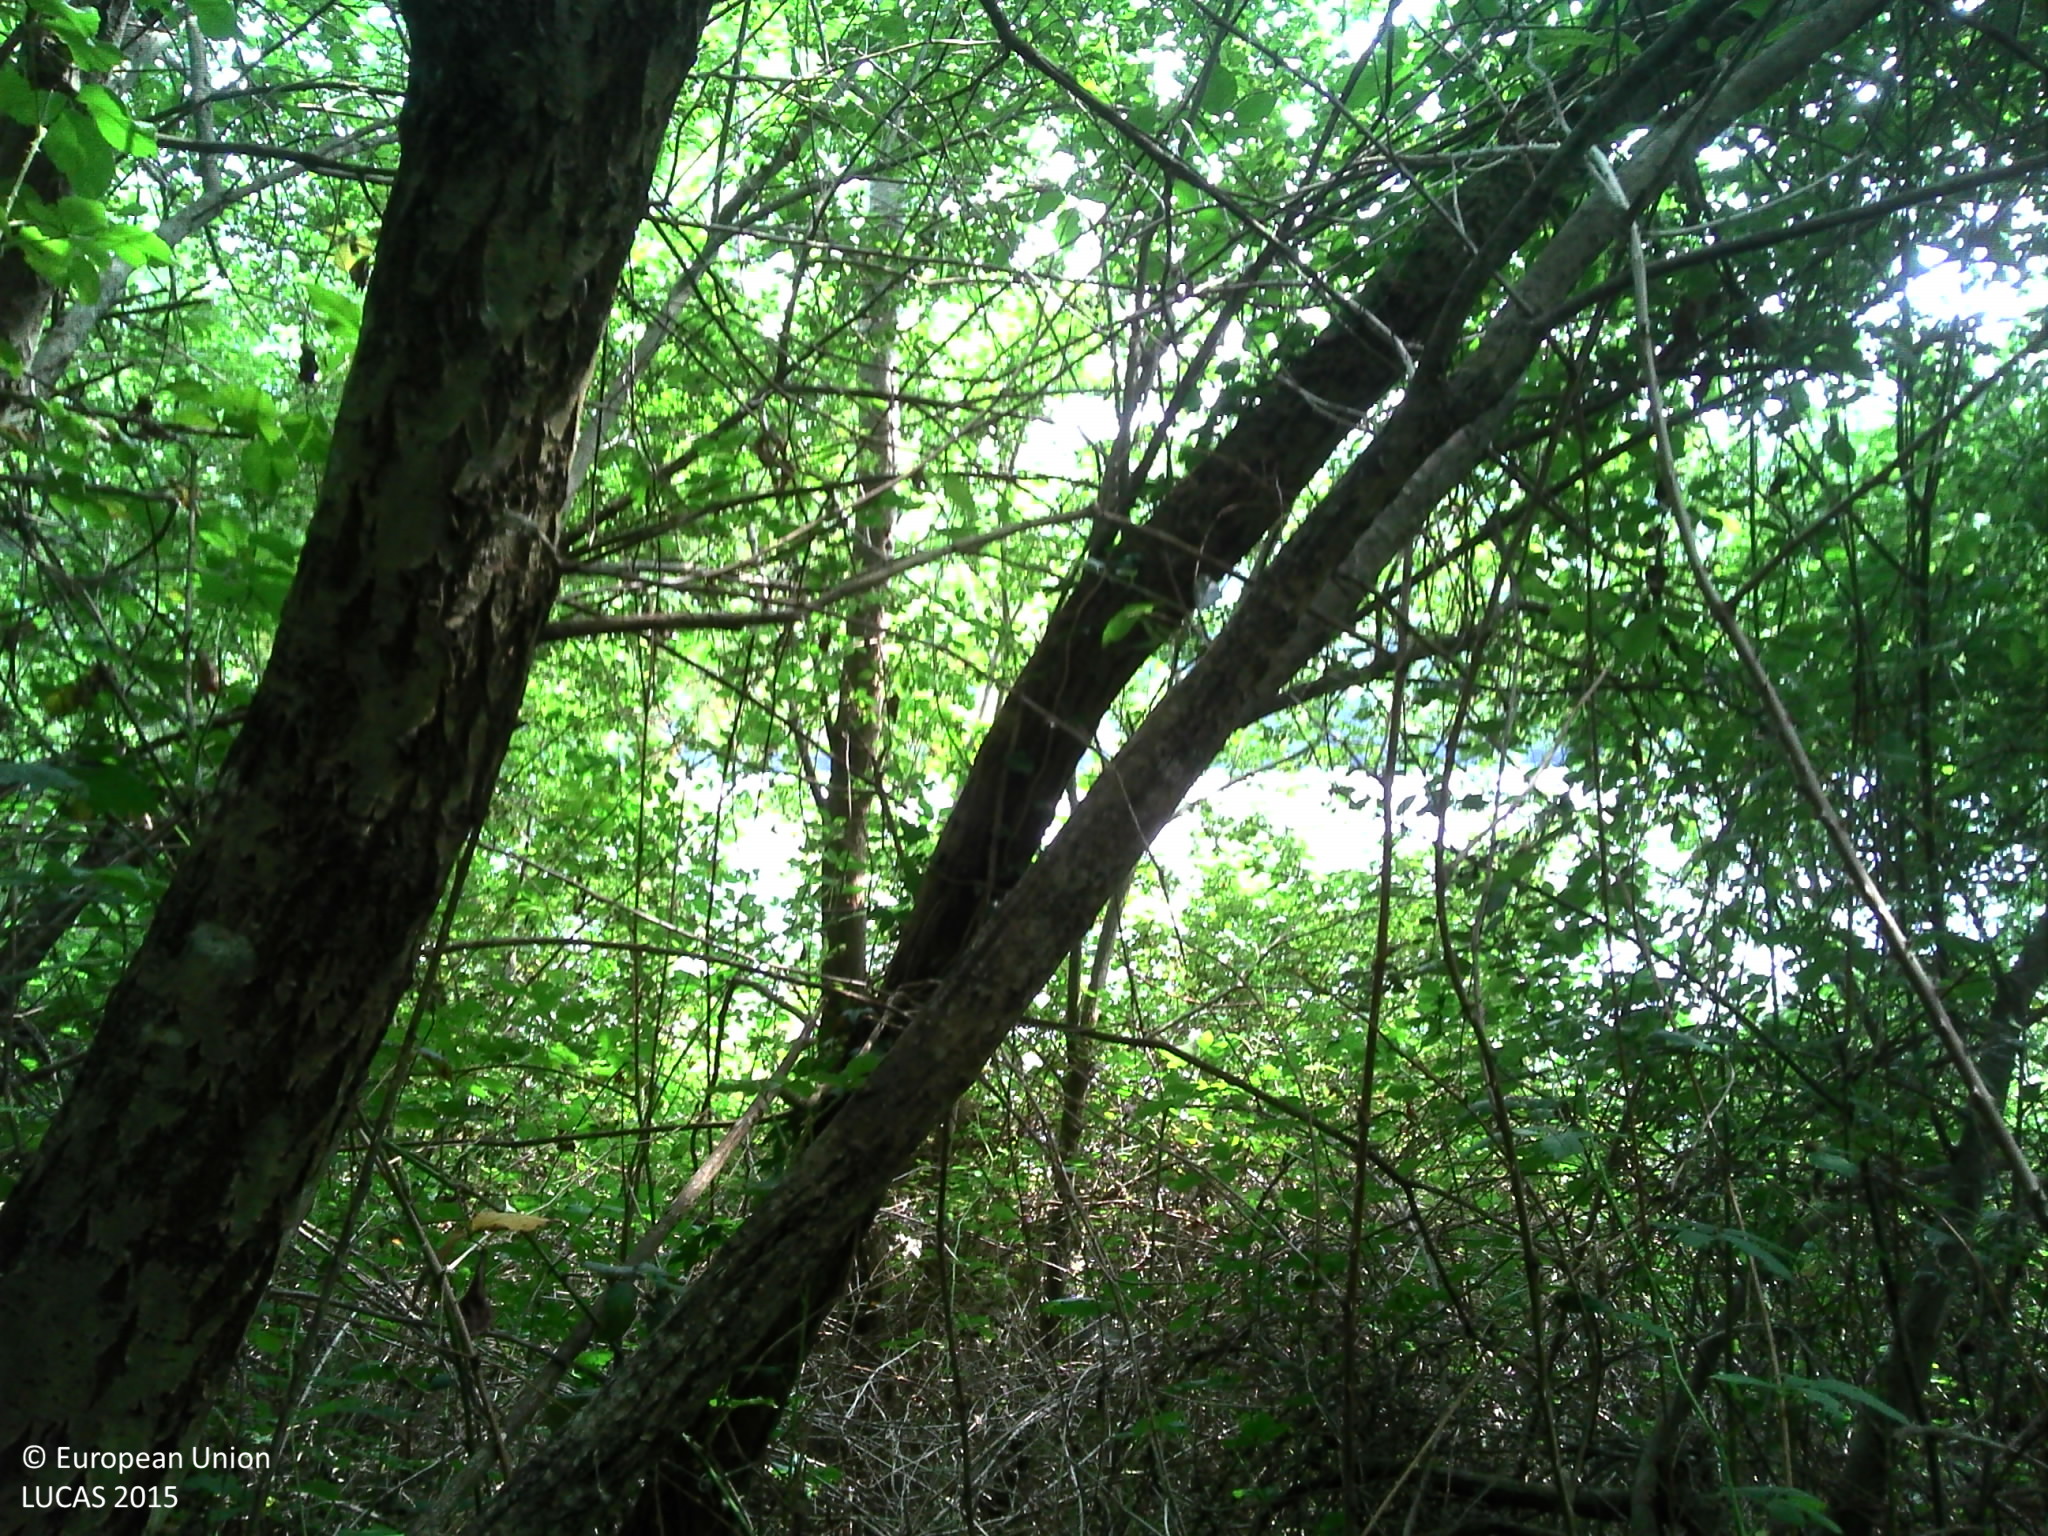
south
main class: Woodland
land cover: Broadleaved woodland
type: acidophilous oak and oak-birch forest
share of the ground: > 75 %
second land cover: Spontaneously vegetated surfaces
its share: > 75 %
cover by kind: broadleaved forest trees 85 %, herbaceous plants 15 %
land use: Semi-natural and natural areas not in use
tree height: > 5 m
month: July
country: FR
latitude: 43.0678
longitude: 1.3970
